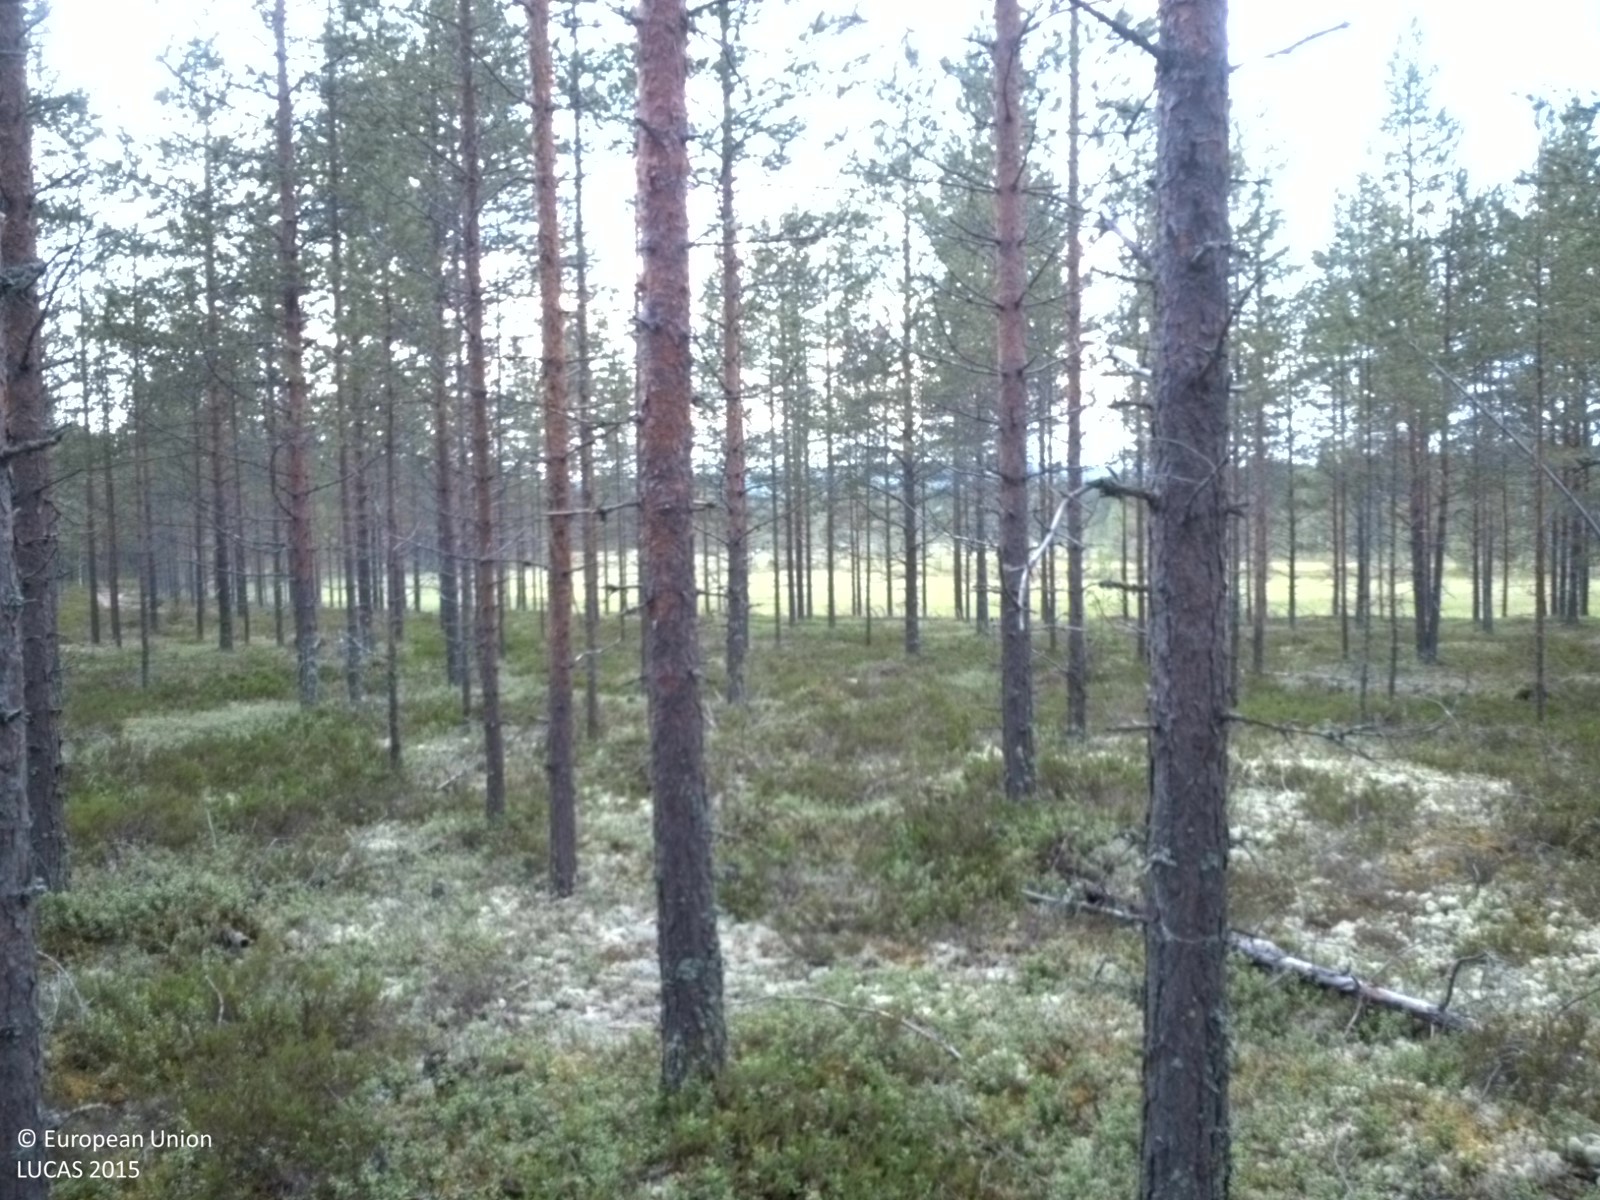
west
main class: Woodland
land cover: Pine dominated coniferous woodland
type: boreal forest
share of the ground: 25 - 50 %
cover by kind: lichens and mosses 75 %, coniferous forest trees 25 %
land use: Forestry
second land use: Amenities, museums, leisure
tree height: > 5 m
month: July
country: SE
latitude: 63.5893
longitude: 19.4297
